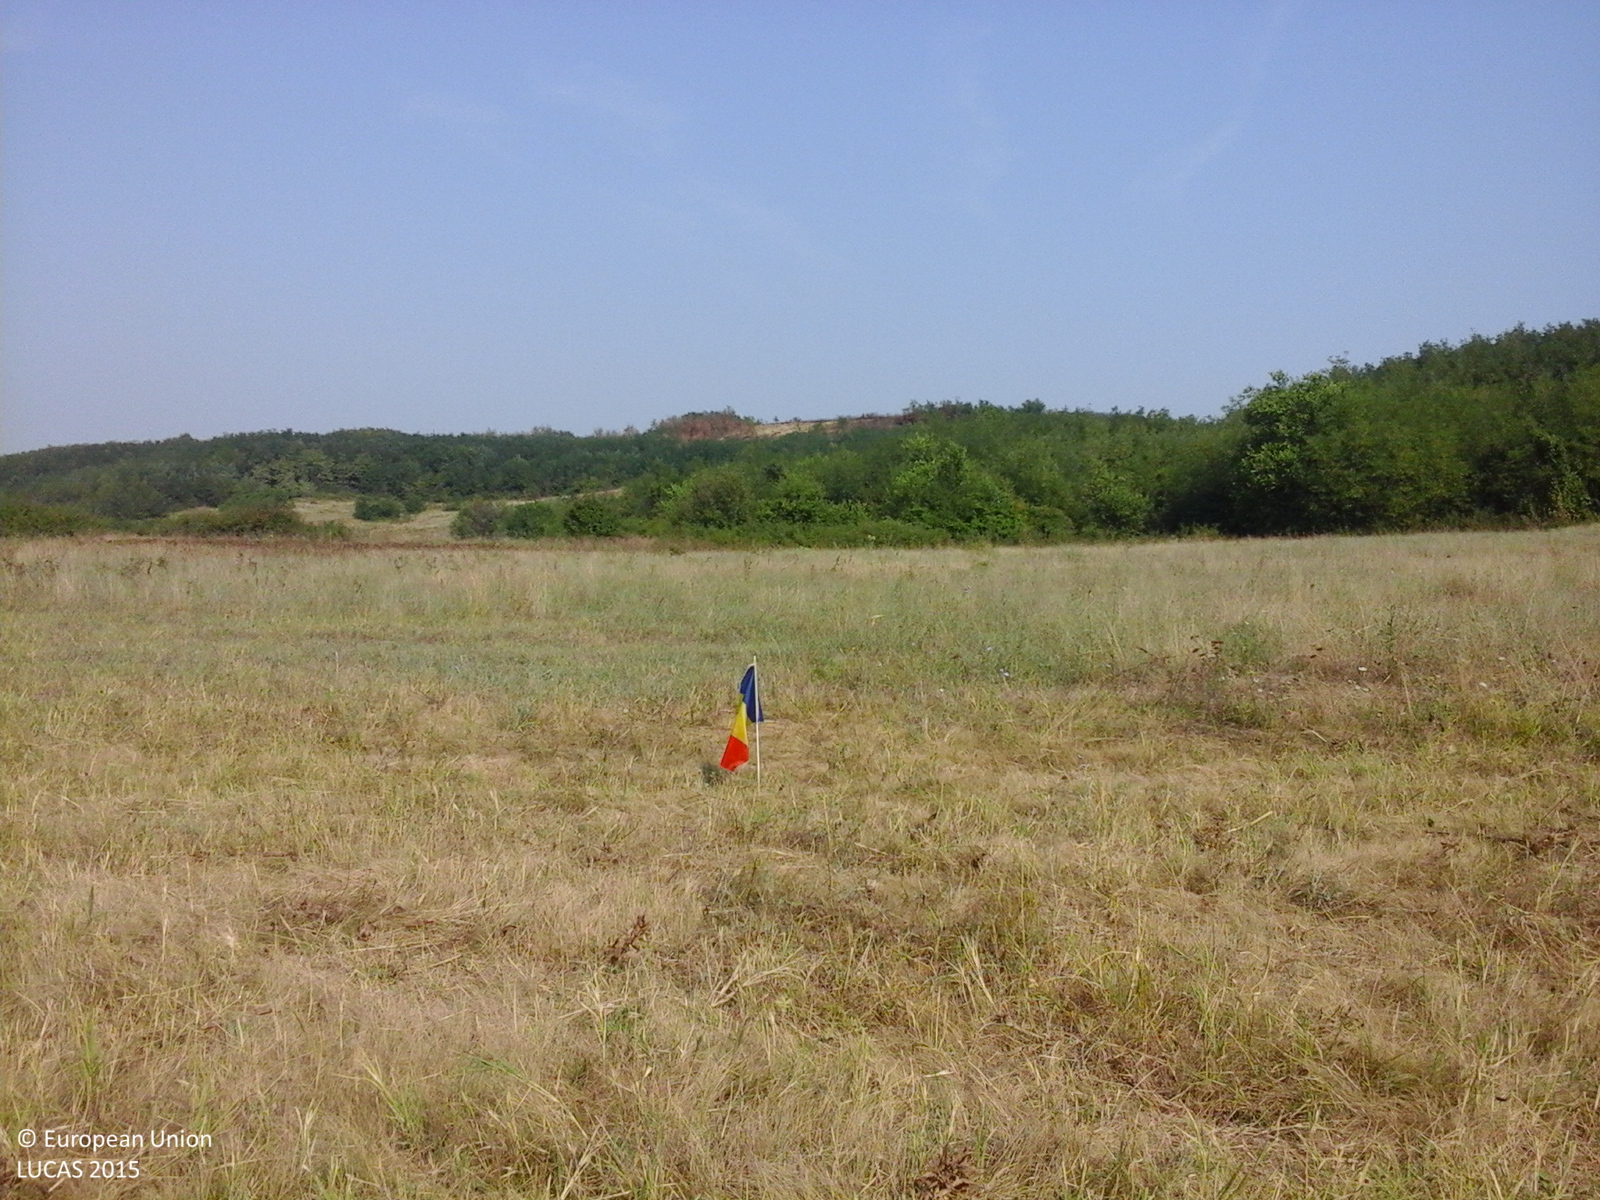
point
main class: Grassland
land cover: Grassland without tree/shrub cover
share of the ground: > 75 %
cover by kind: herbaceous plants 100 %
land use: Agriculture (excluding fallow land and kitchen gardens)
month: August
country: RO
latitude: 44.4852
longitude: 23.0857
